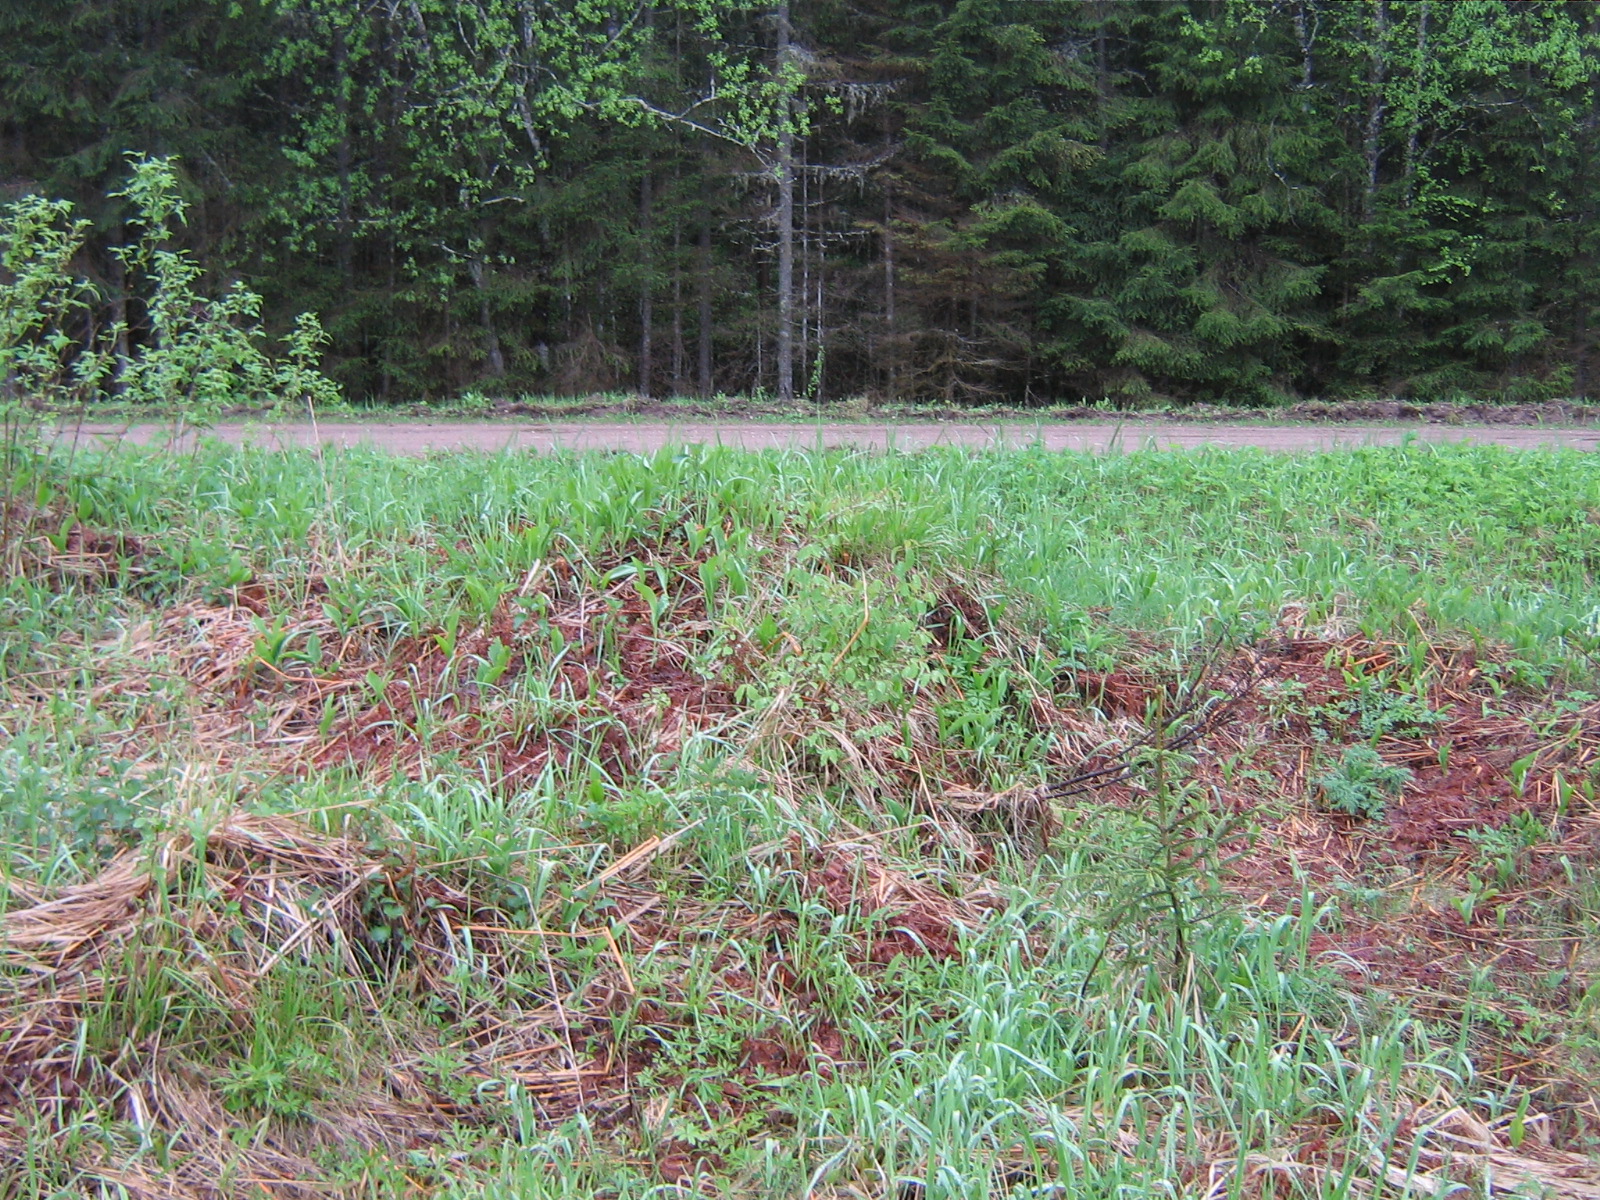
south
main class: Woodland
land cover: Spruce dominated mixed woodland
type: hemiboreal forest and nemoral coniferous forest and mixed broadleaved-coniferous forest
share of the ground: 25 - 50 %
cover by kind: herbaceous plants 60 %, coniferous forest trees 25 %, broadleaved forest trees 15 %
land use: Forestry
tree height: < 5 m
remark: Clear cut
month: May
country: LV
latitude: 57.3126
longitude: 25.9499
